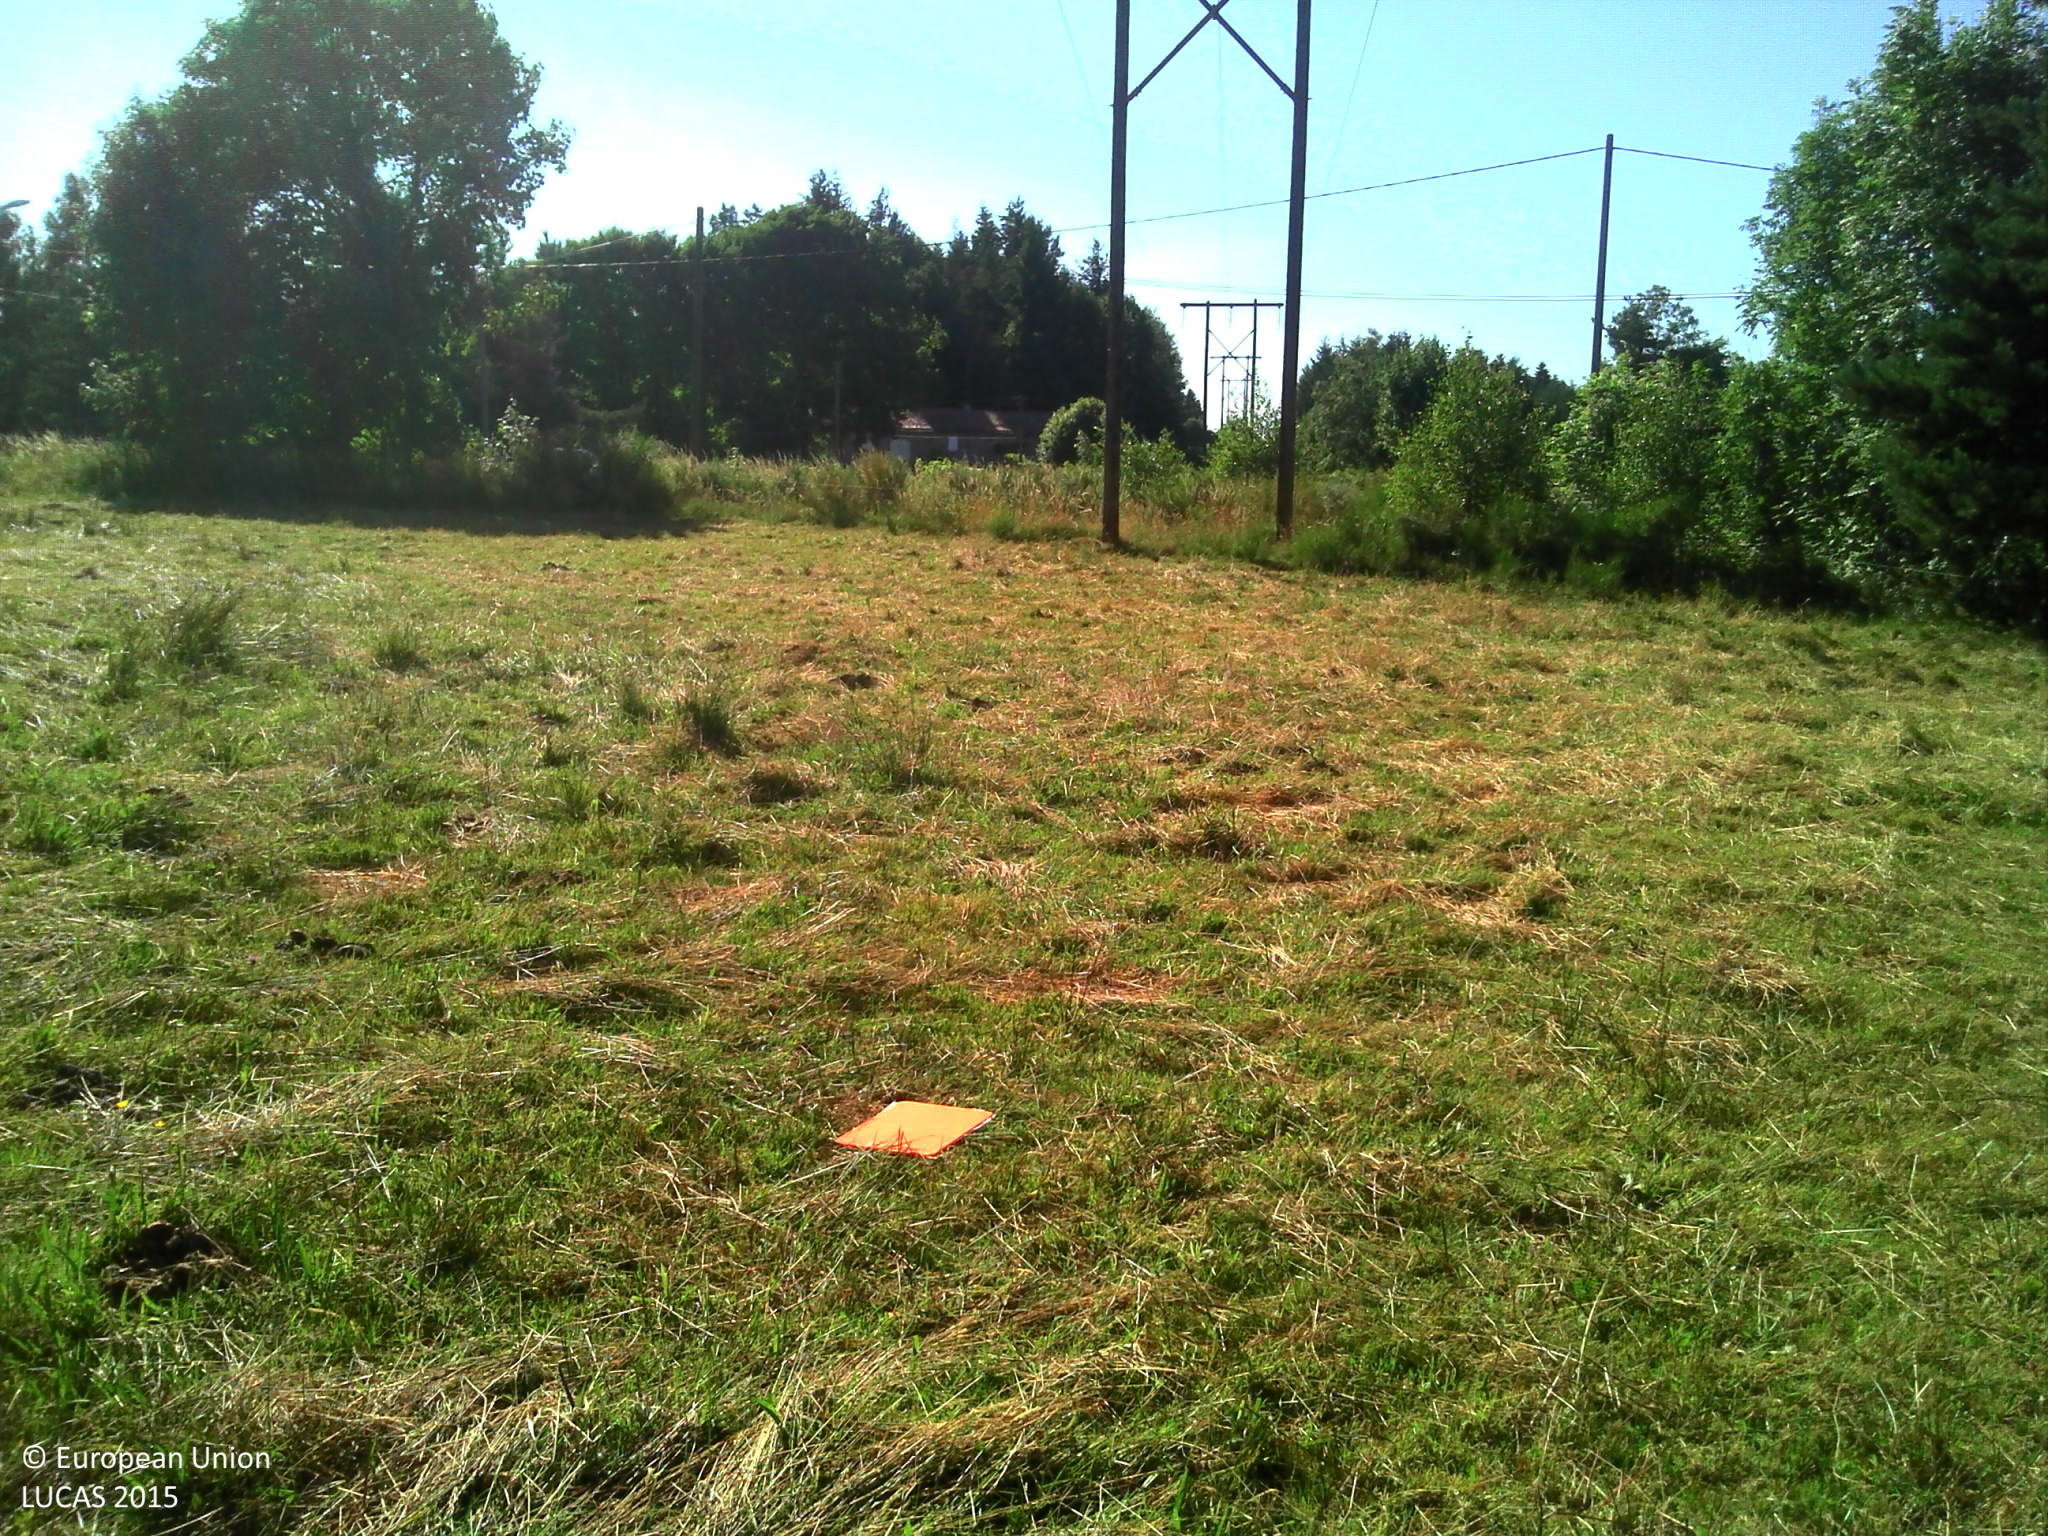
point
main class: Grassland
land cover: Grassland without tree/shrub cover
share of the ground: > 75 %
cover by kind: herbaceous plants 100 %
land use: Agriculture (excluding fallow land and kitchen gardens)
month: July
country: FR
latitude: 45.0947
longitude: 4.2484
